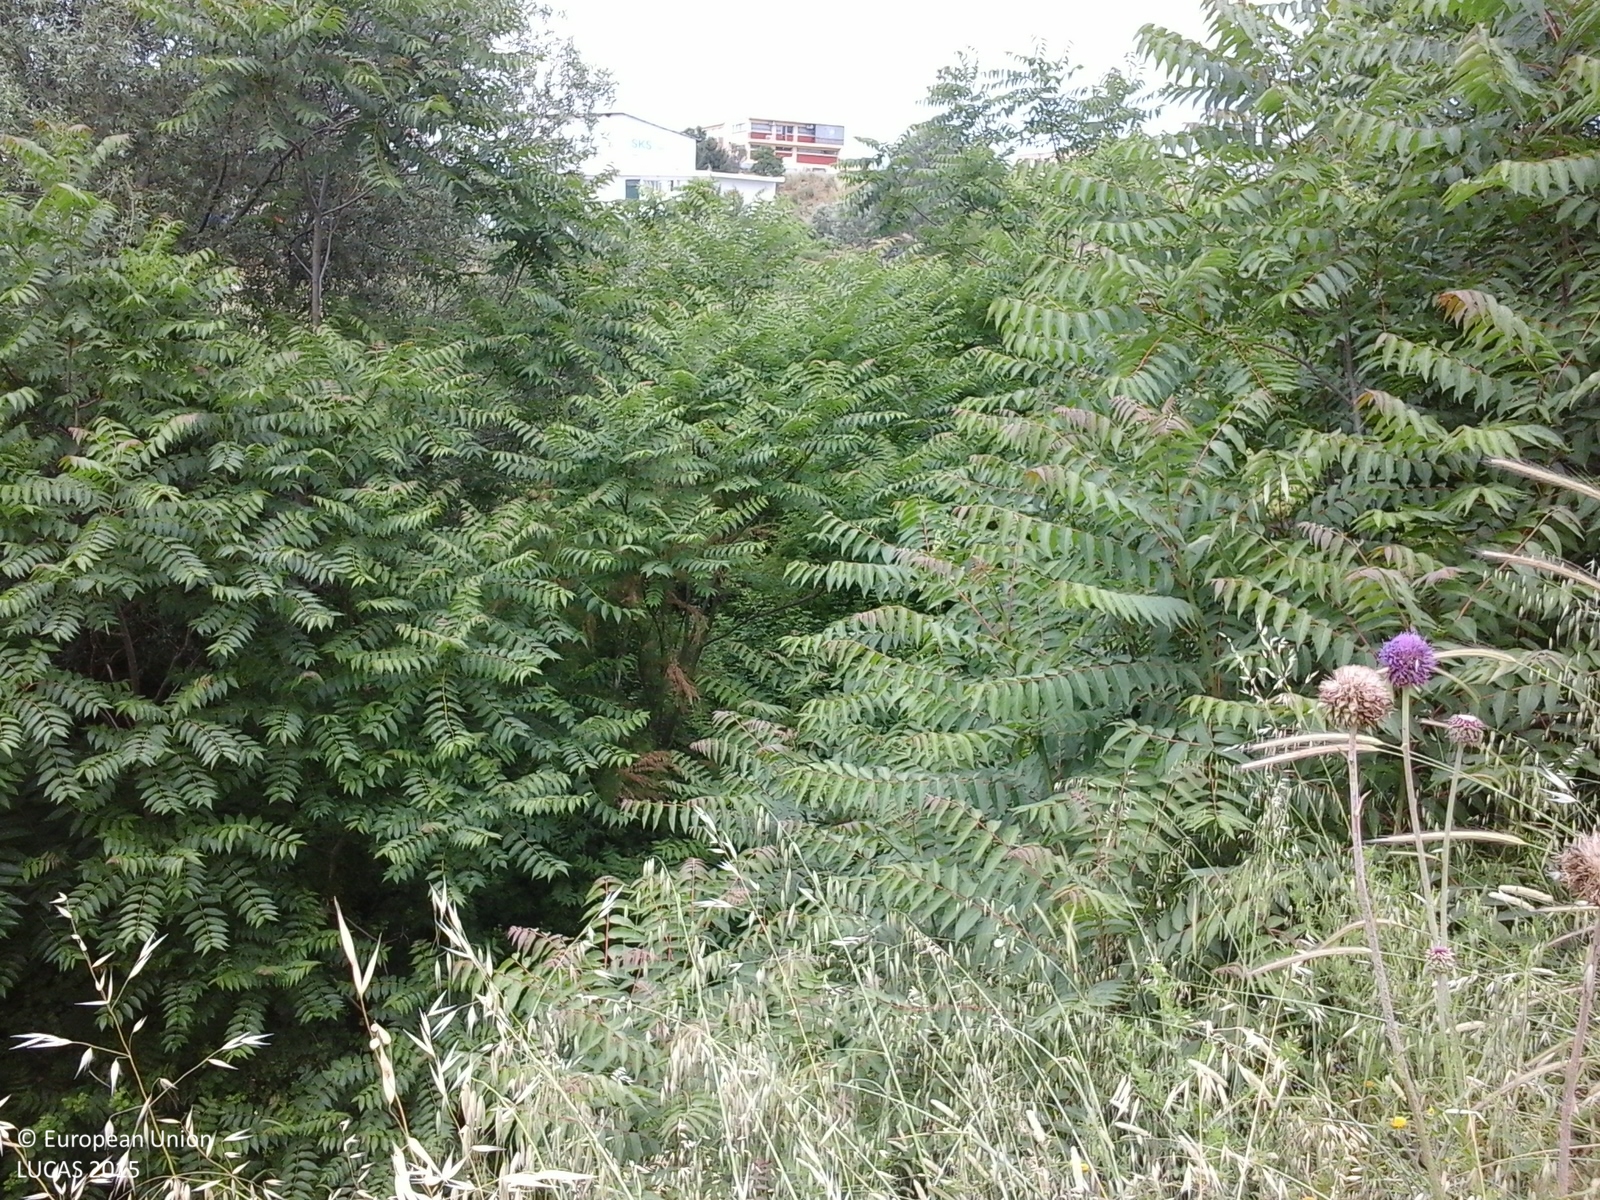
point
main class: Woodland
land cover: Broadleaved woodland
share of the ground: > 75 %
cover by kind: broadleaved forest trees 100 %
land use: Semi-natural and natural areas not in use
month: May
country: GR
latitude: 40.7047
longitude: 22.9445
